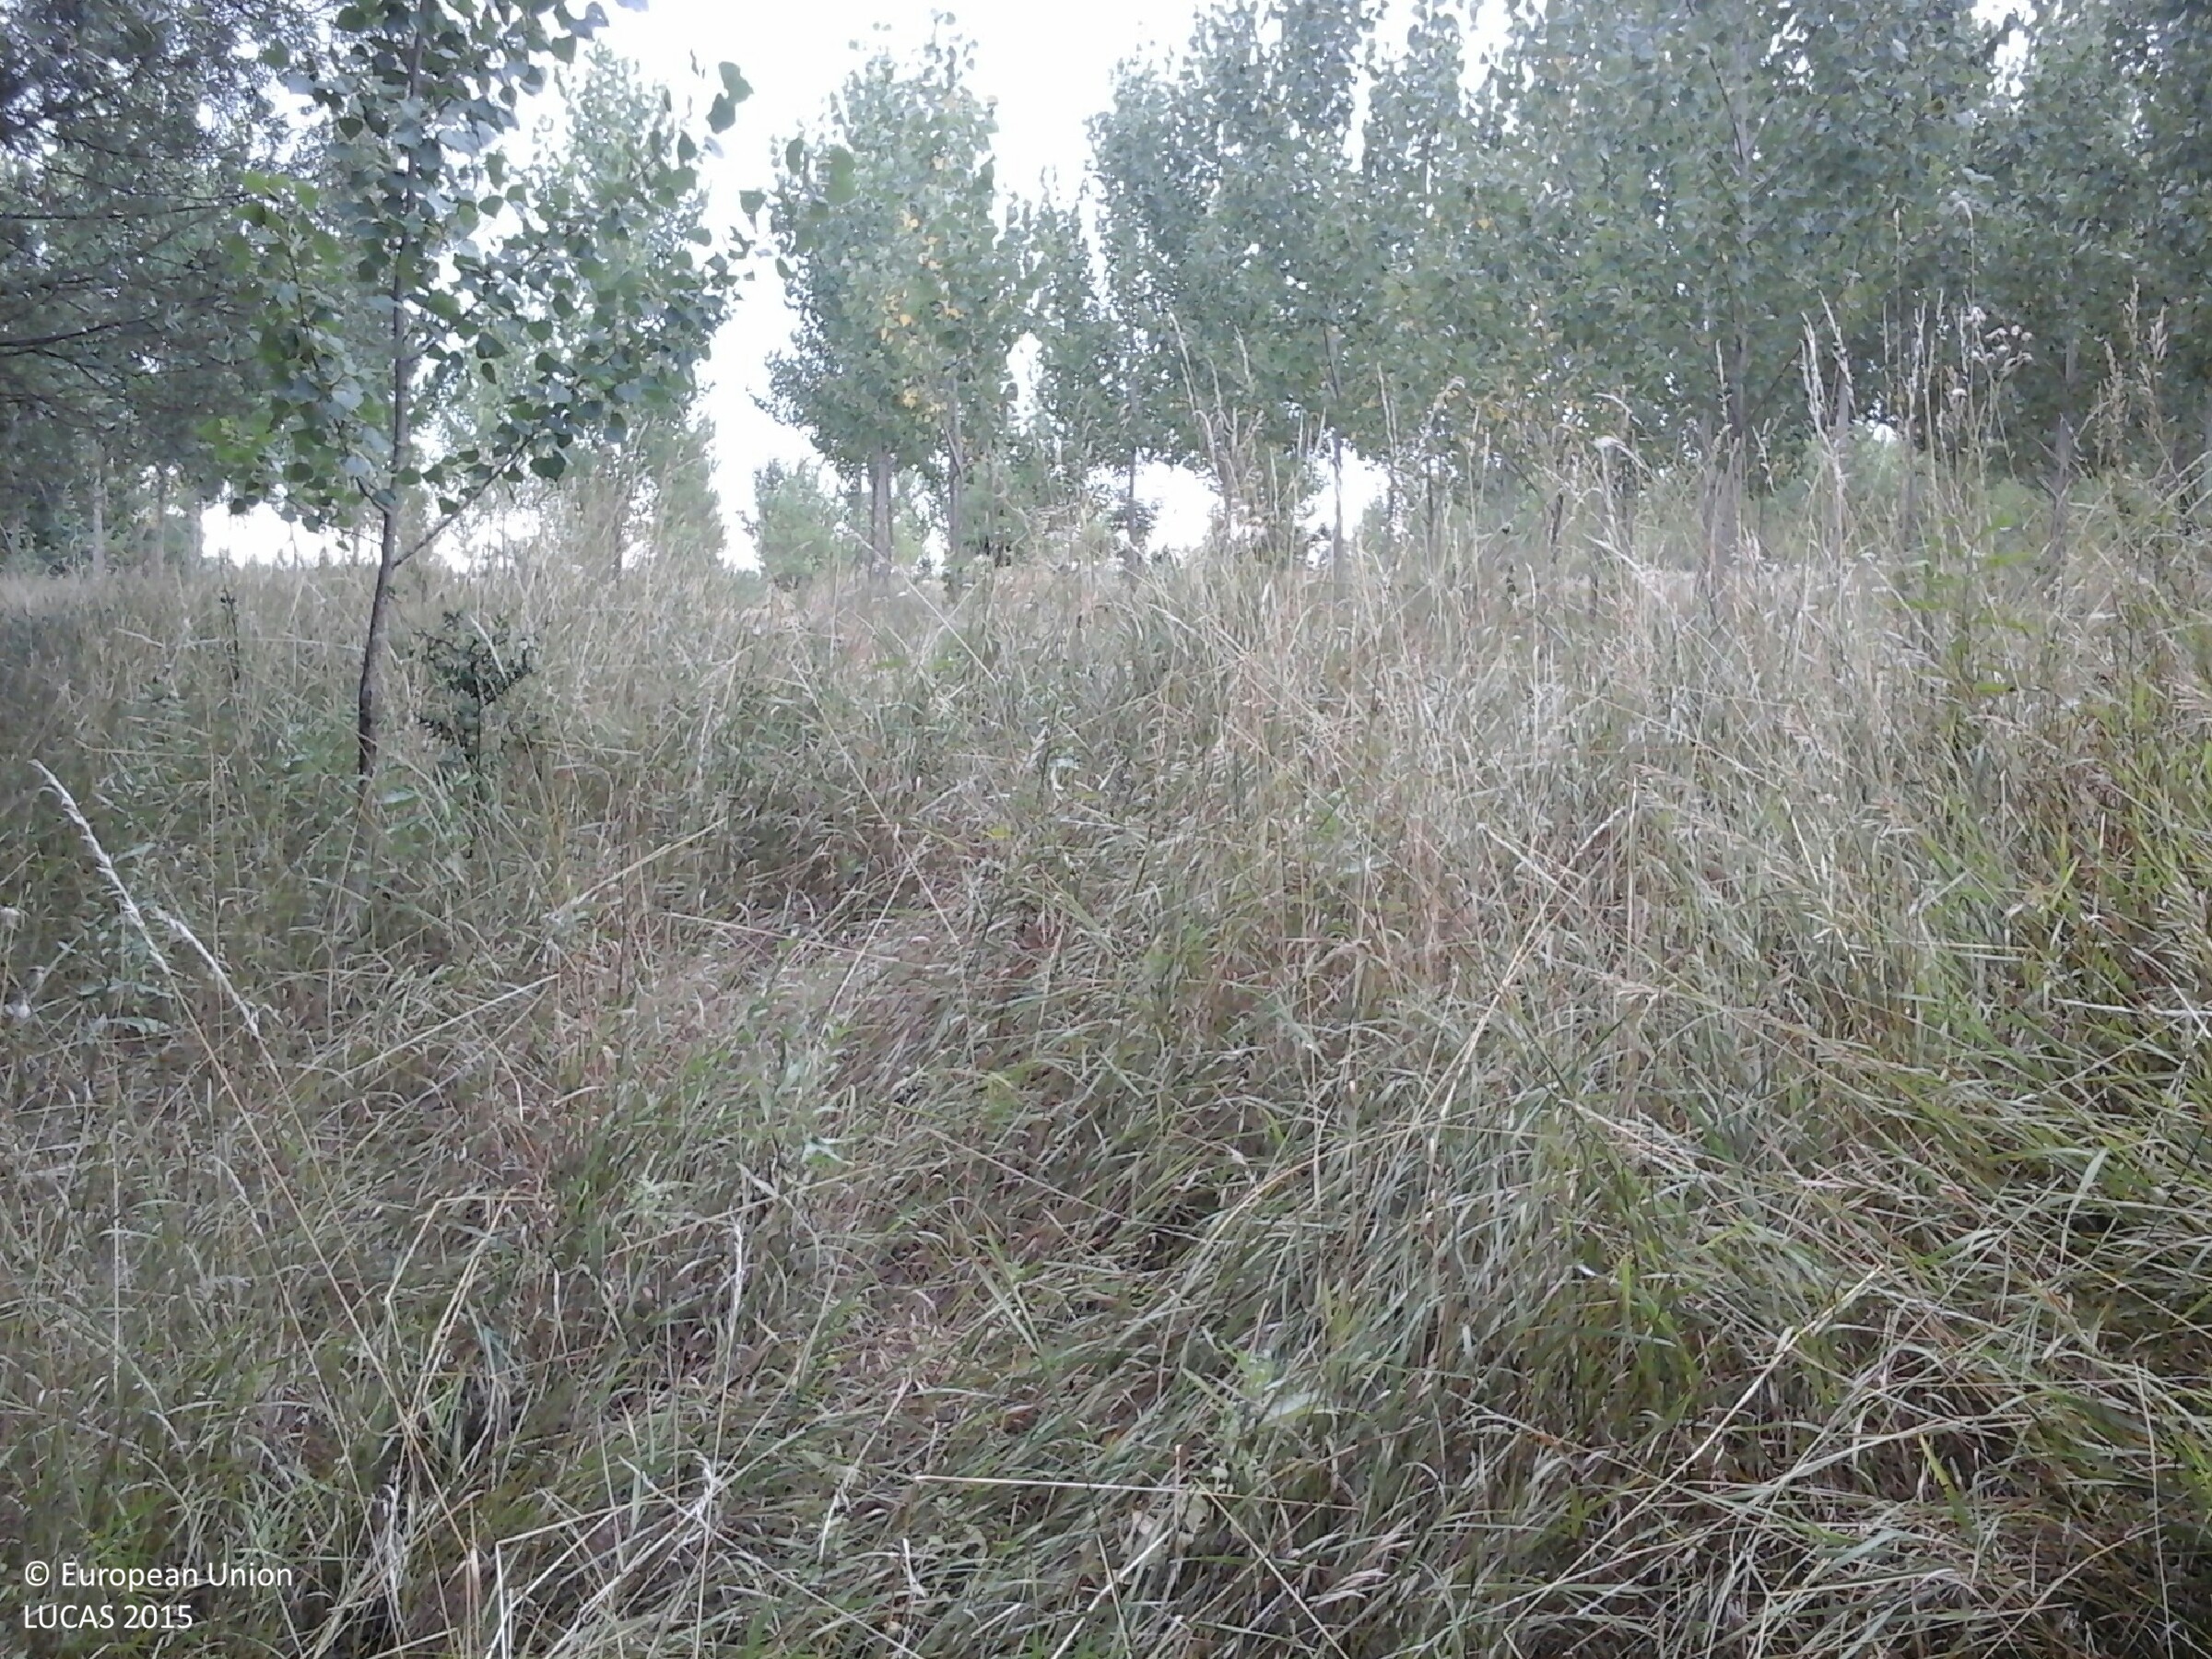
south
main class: Woodland
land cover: Broadleaved woodland
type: mesophytic deciduous forest
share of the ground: 50 - 75 %
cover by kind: broadleaved forest trees 70 %, herbaceous plants 30 %
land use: Forestry
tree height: > 5 m
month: July
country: HU
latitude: 47.5277
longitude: 20.6183
